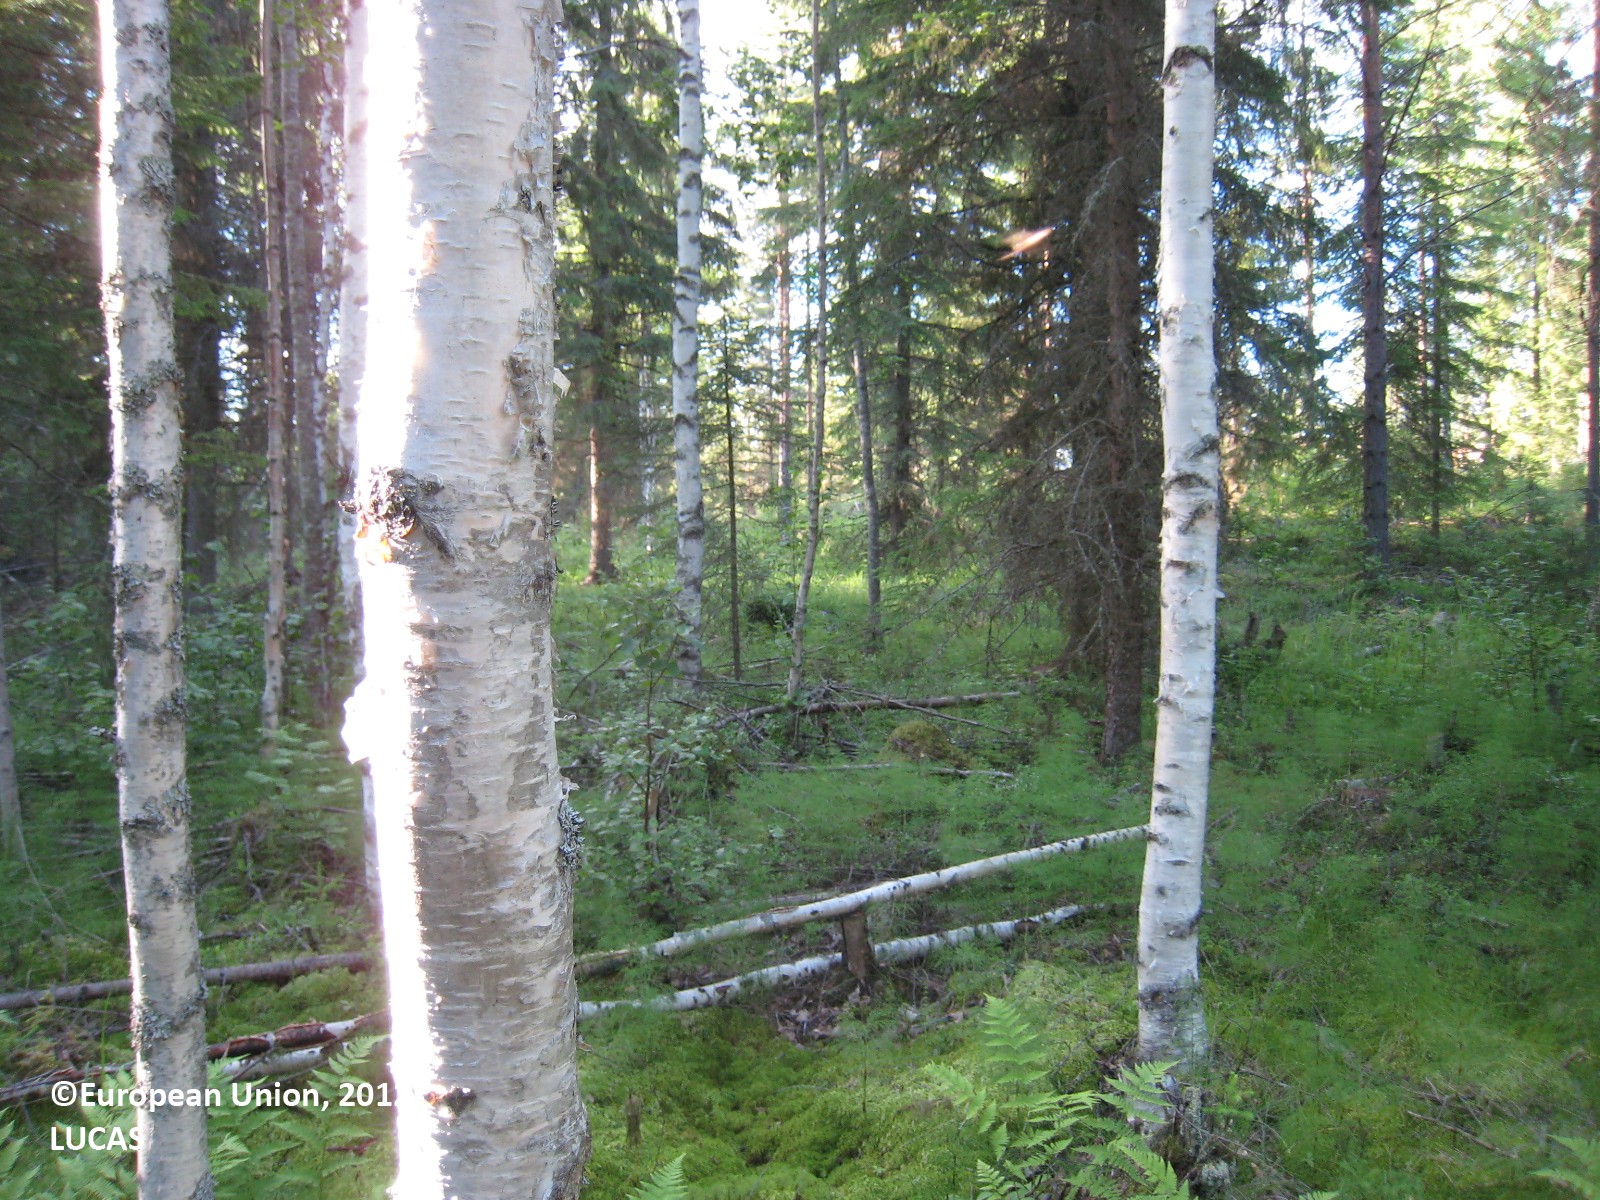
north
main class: Woodland
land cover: Spruce dominated mixed woodland
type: boreal forest
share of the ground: 50 - 75 %
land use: Forestry
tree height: > 5 m
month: July
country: FI
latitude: 63.1486
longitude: 25.6876
